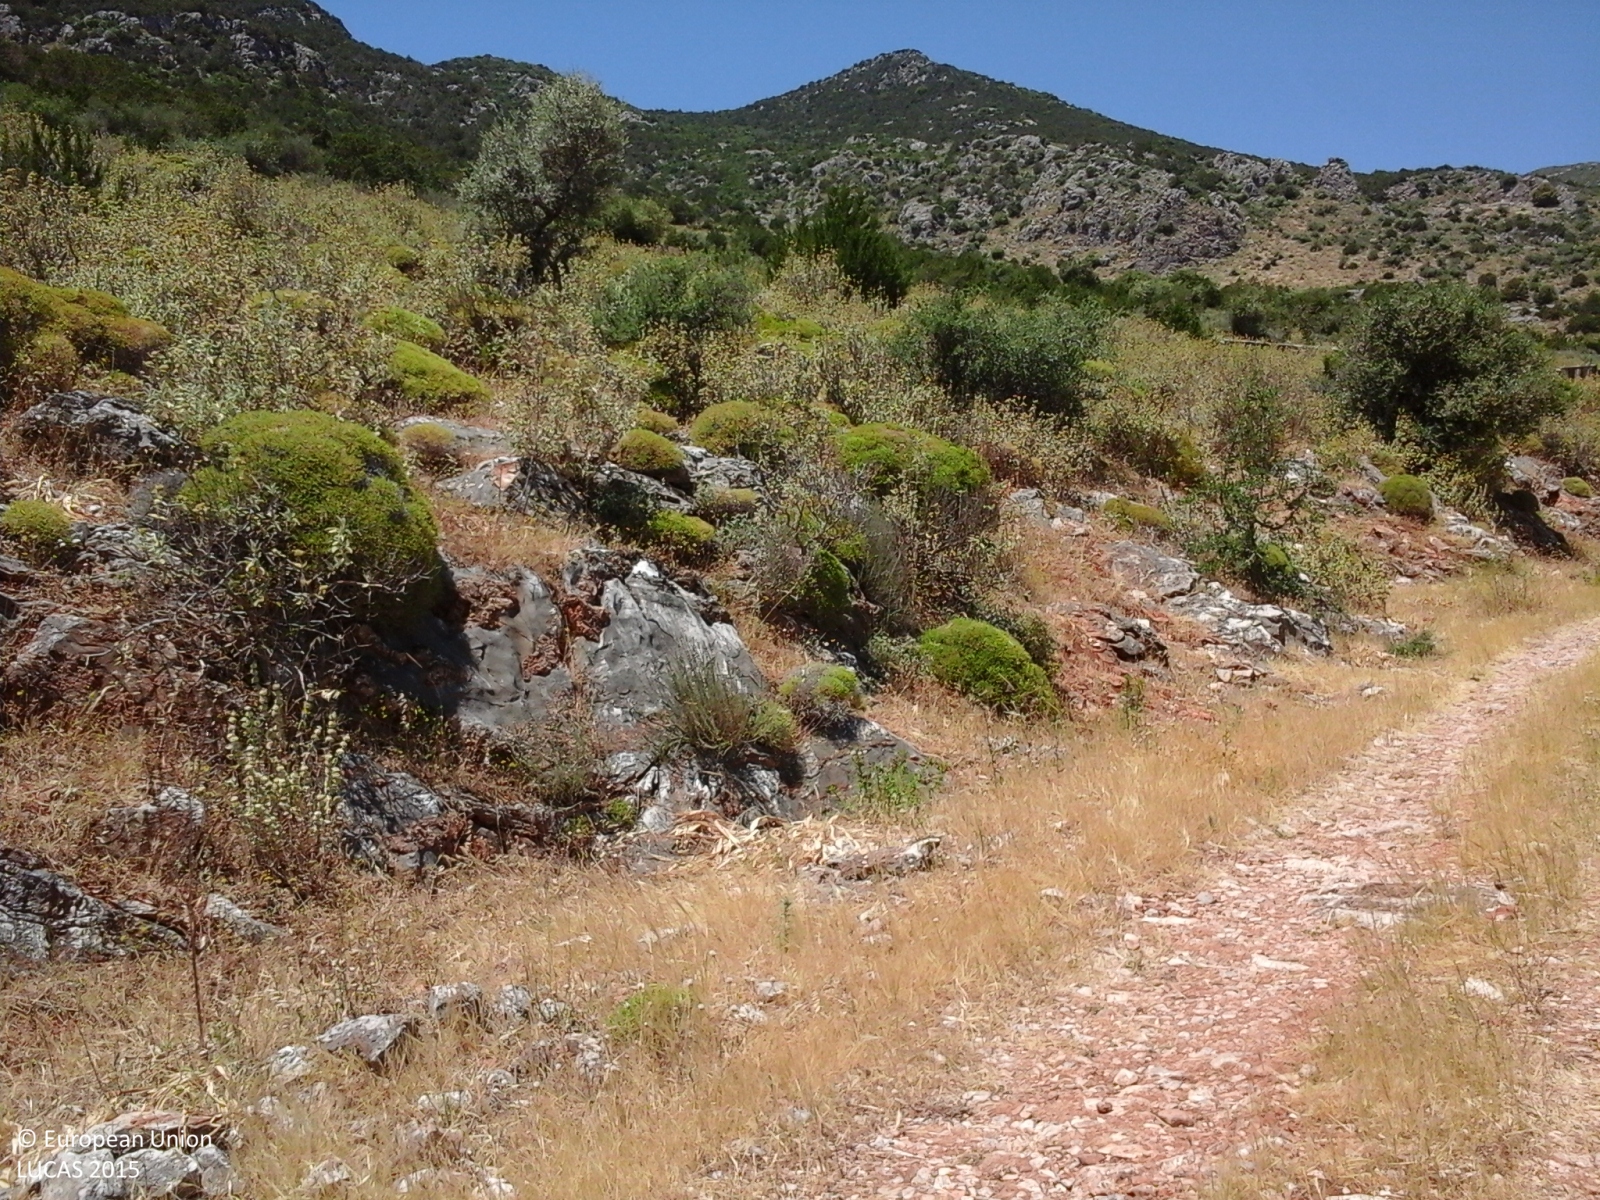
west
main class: Shrubland
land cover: Shrubland with sparse tree cover
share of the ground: 50 - 75 %
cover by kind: shrubs 55 %, herbaceous plants 10 %, unconsolidated bare surface 10 %, coniferous forest trees 5 %
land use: Semi-natural and natural areas not in use
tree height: < 5 m
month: May
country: GR
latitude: 38.3708
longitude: 22.1848
